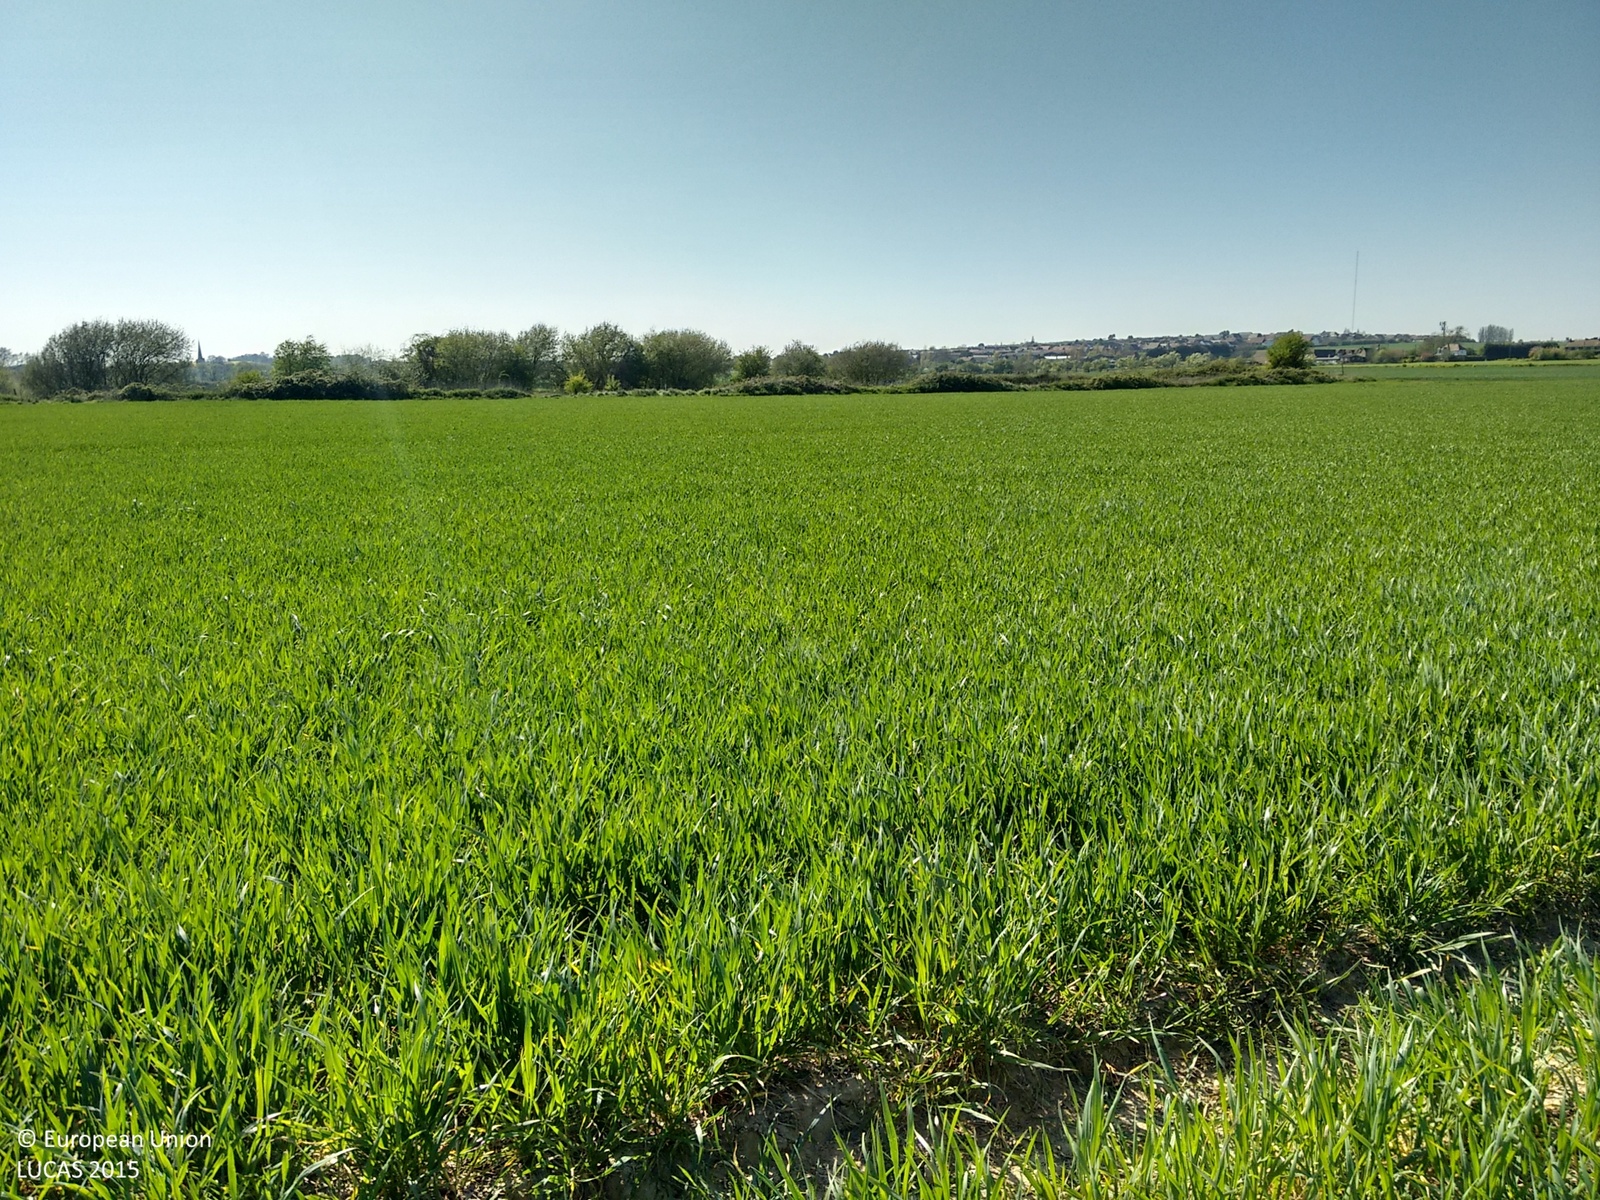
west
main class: Cropland
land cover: Common wheat
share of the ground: > 75 %
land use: Agriculture (excluding fallow land and kitchen gardens)
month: April
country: GB
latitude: 51.4230
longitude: 0.5820
